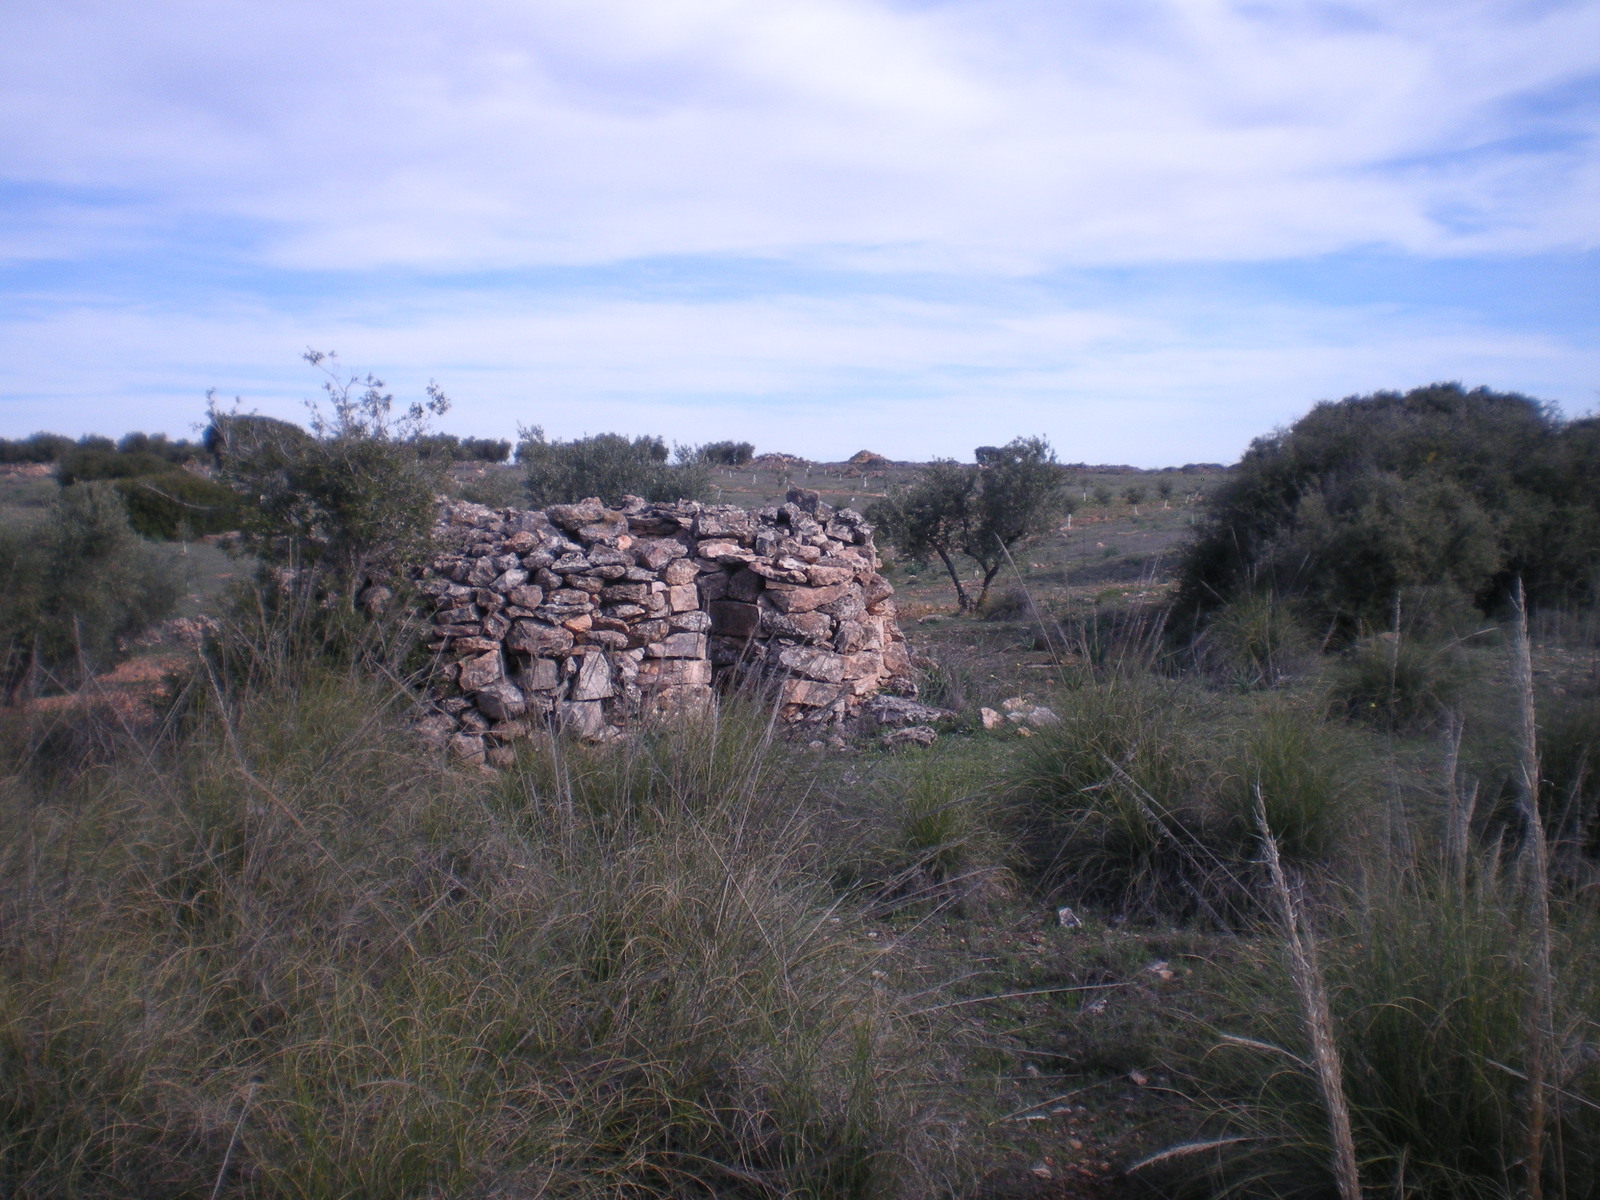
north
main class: Shrubland
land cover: Shrubland with sparse tree cover
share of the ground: 50 - 75 %
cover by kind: shrubs 50 %, herbaceous plants 45 %, broadleaved forest trees 5 %
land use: Semi-natural and natural areas not in use
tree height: < 5 m
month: March
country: ES
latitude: 38.9761
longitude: -3.2755
